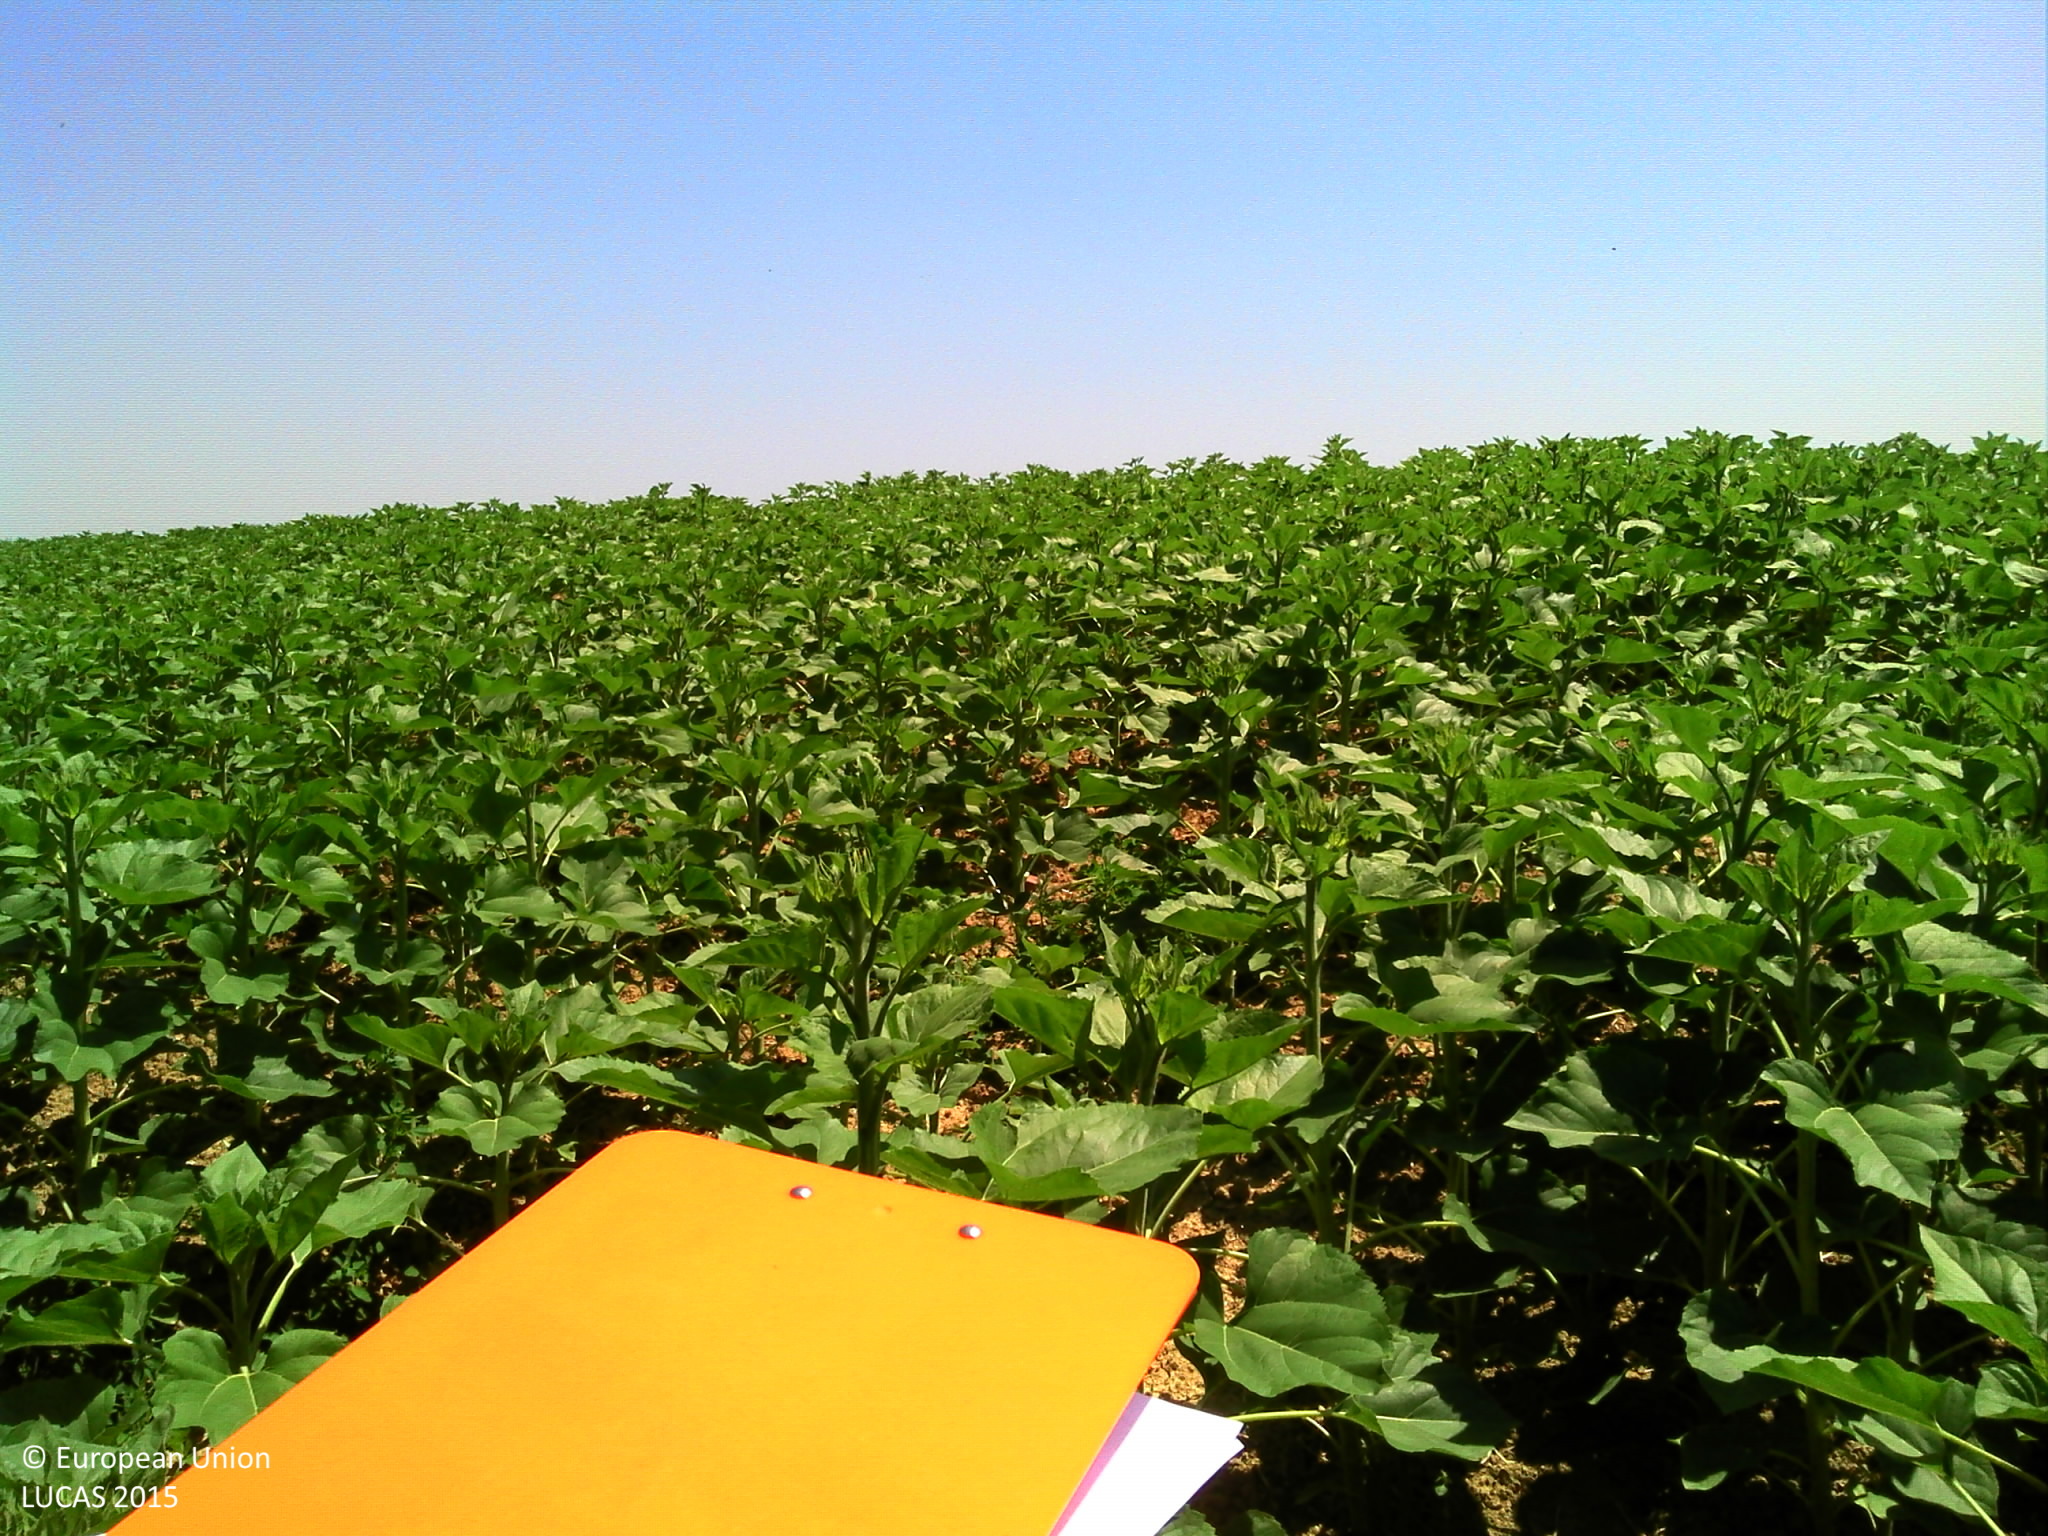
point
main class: Cropland
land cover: Sunflower
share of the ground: > 75 %
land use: Agriculture (excluding fallow land and kitchen gardens)
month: June
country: FR
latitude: 43.7251
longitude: 1.0247
